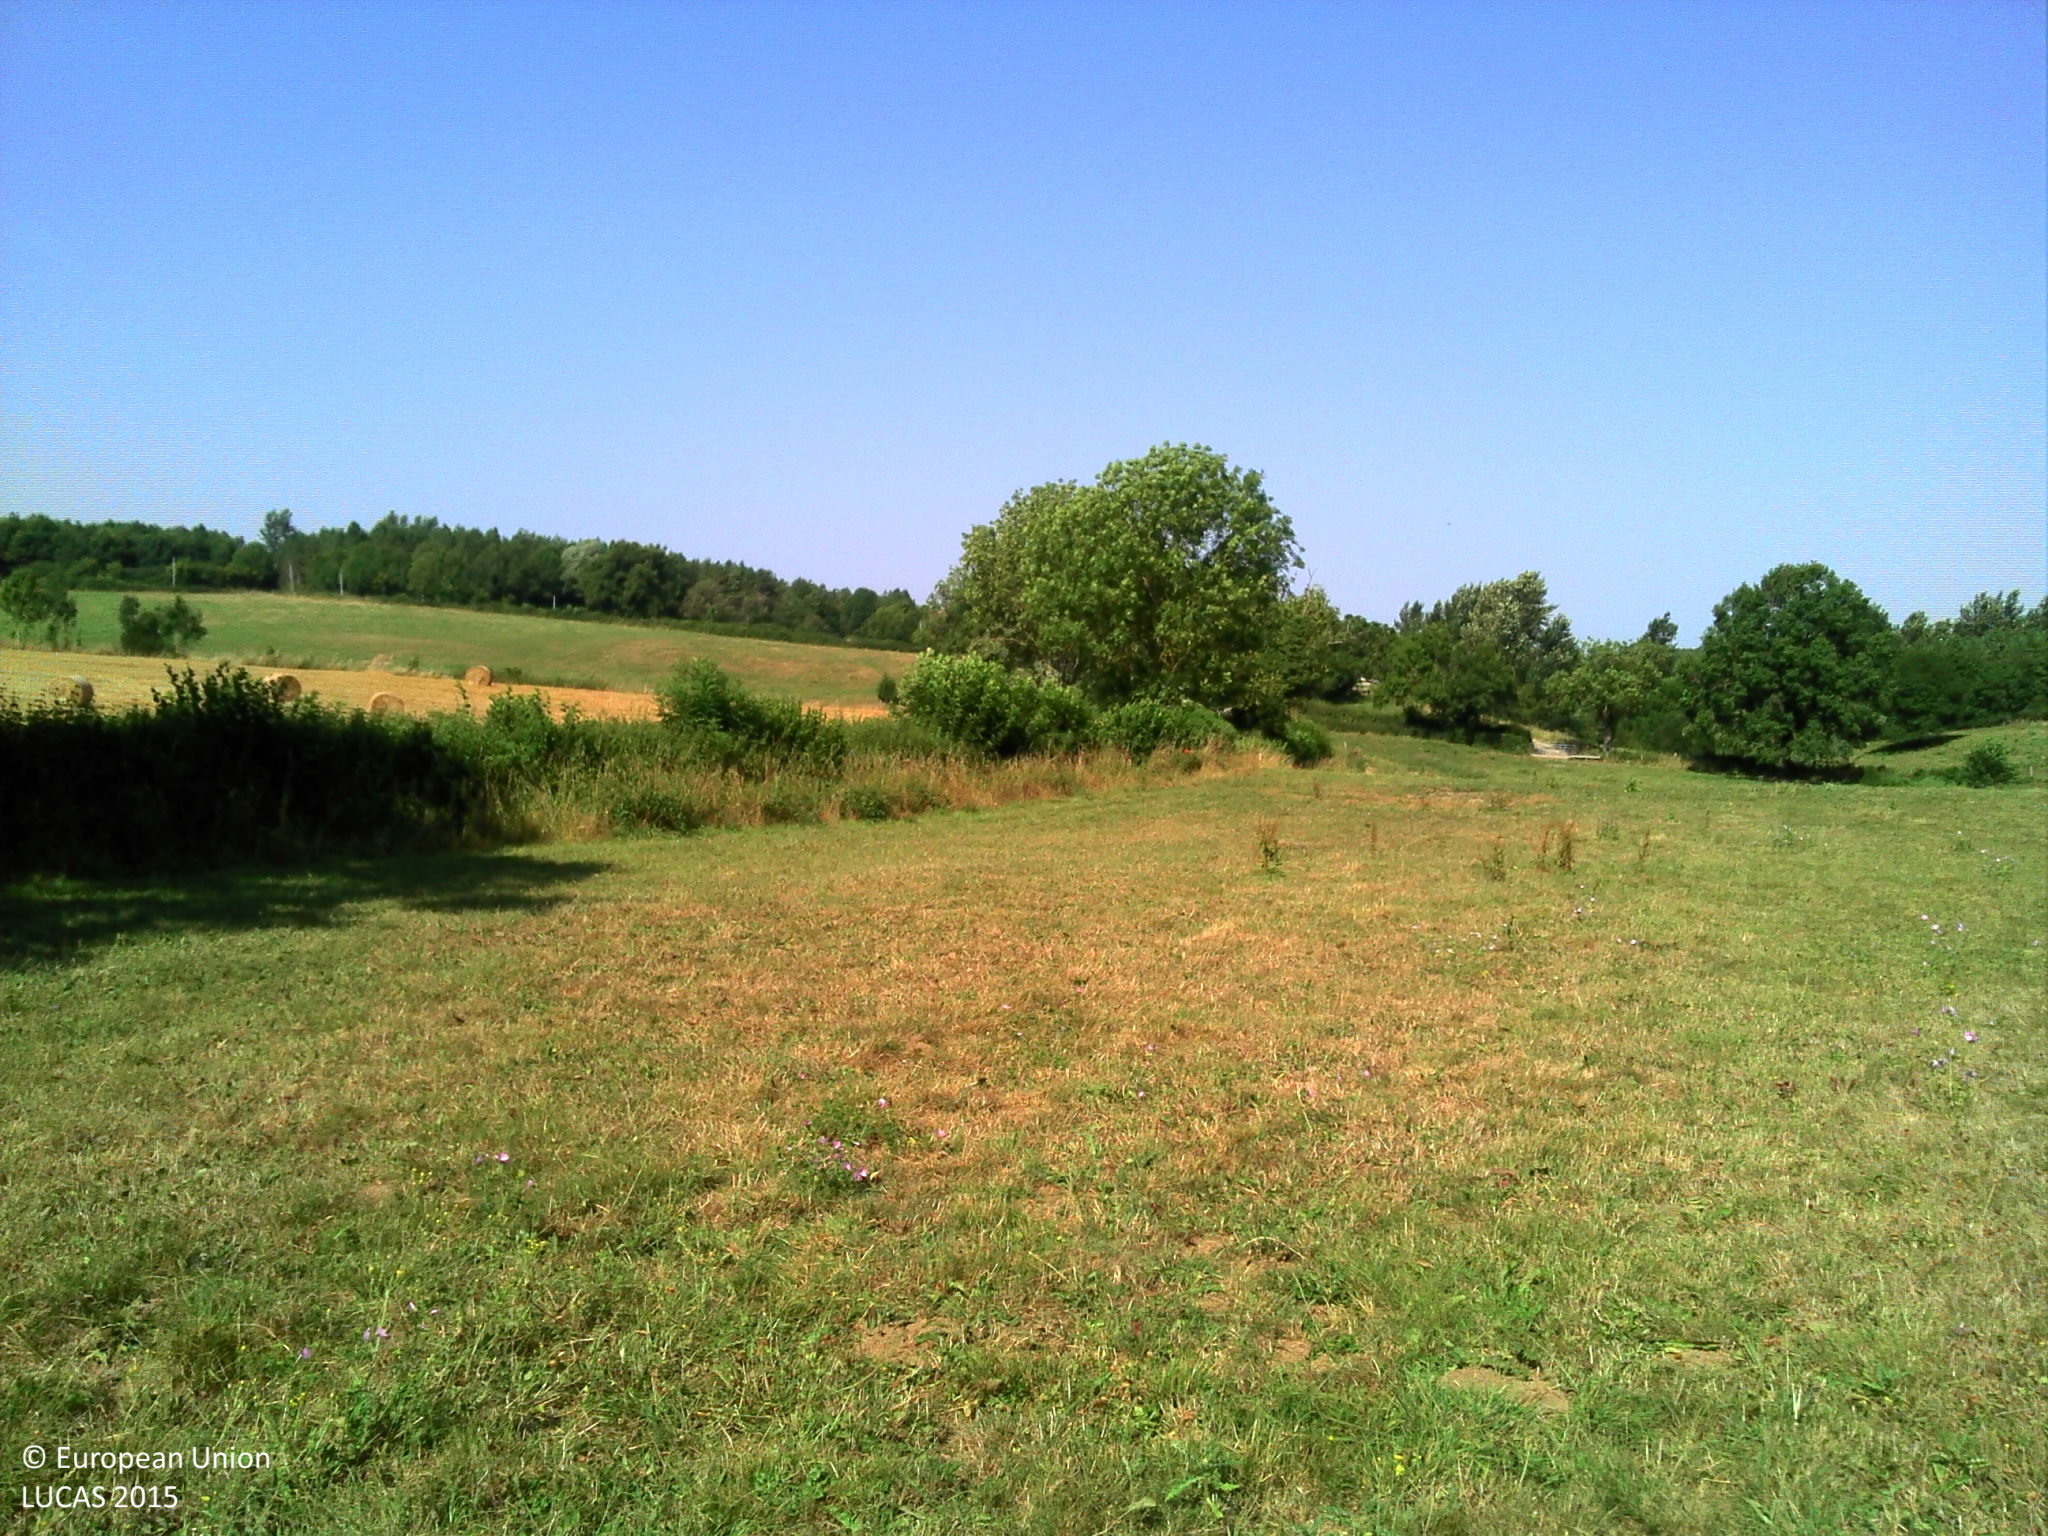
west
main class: Grassland
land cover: Grassland without tree/shrub cover
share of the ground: > 75 %
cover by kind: herbaceous plants 100 %
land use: Agriculture (excluding fallow land and kitchen gardens)
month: July
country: FR
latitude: 46.4655
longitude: 3.0044
